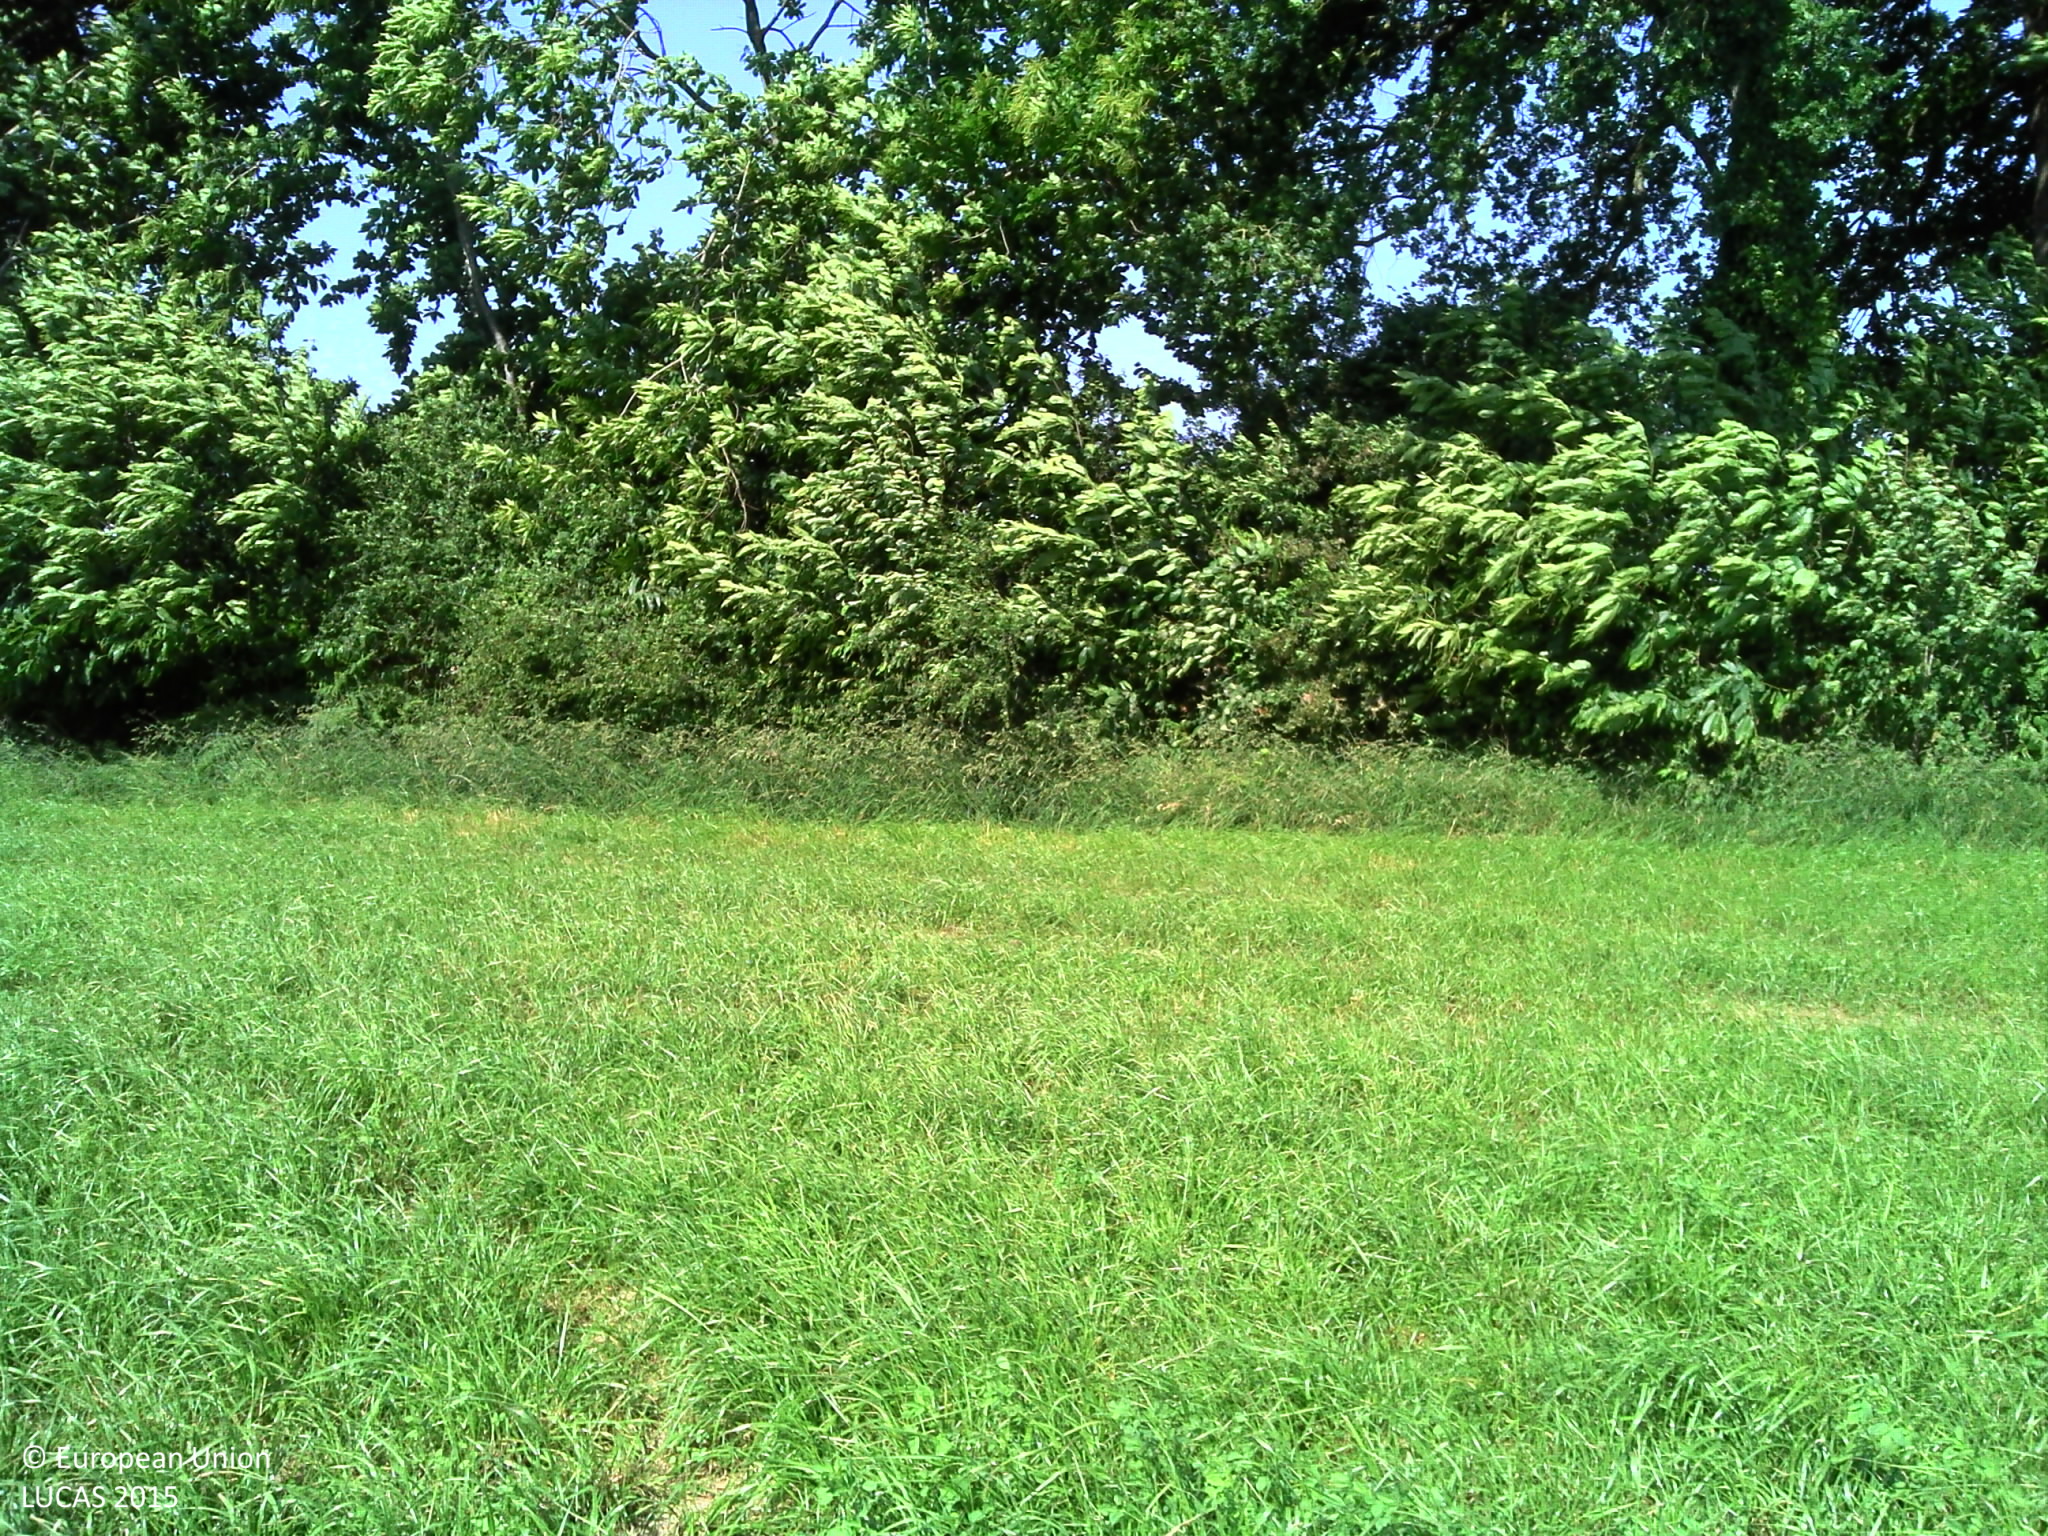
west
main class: Cropland
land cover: Temporary grasslands
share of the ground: > 75 %
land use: Agriculture (excluding fallow land and kitchen gardens)
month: June
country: FR
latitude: 48.0774
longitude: -1.1142
